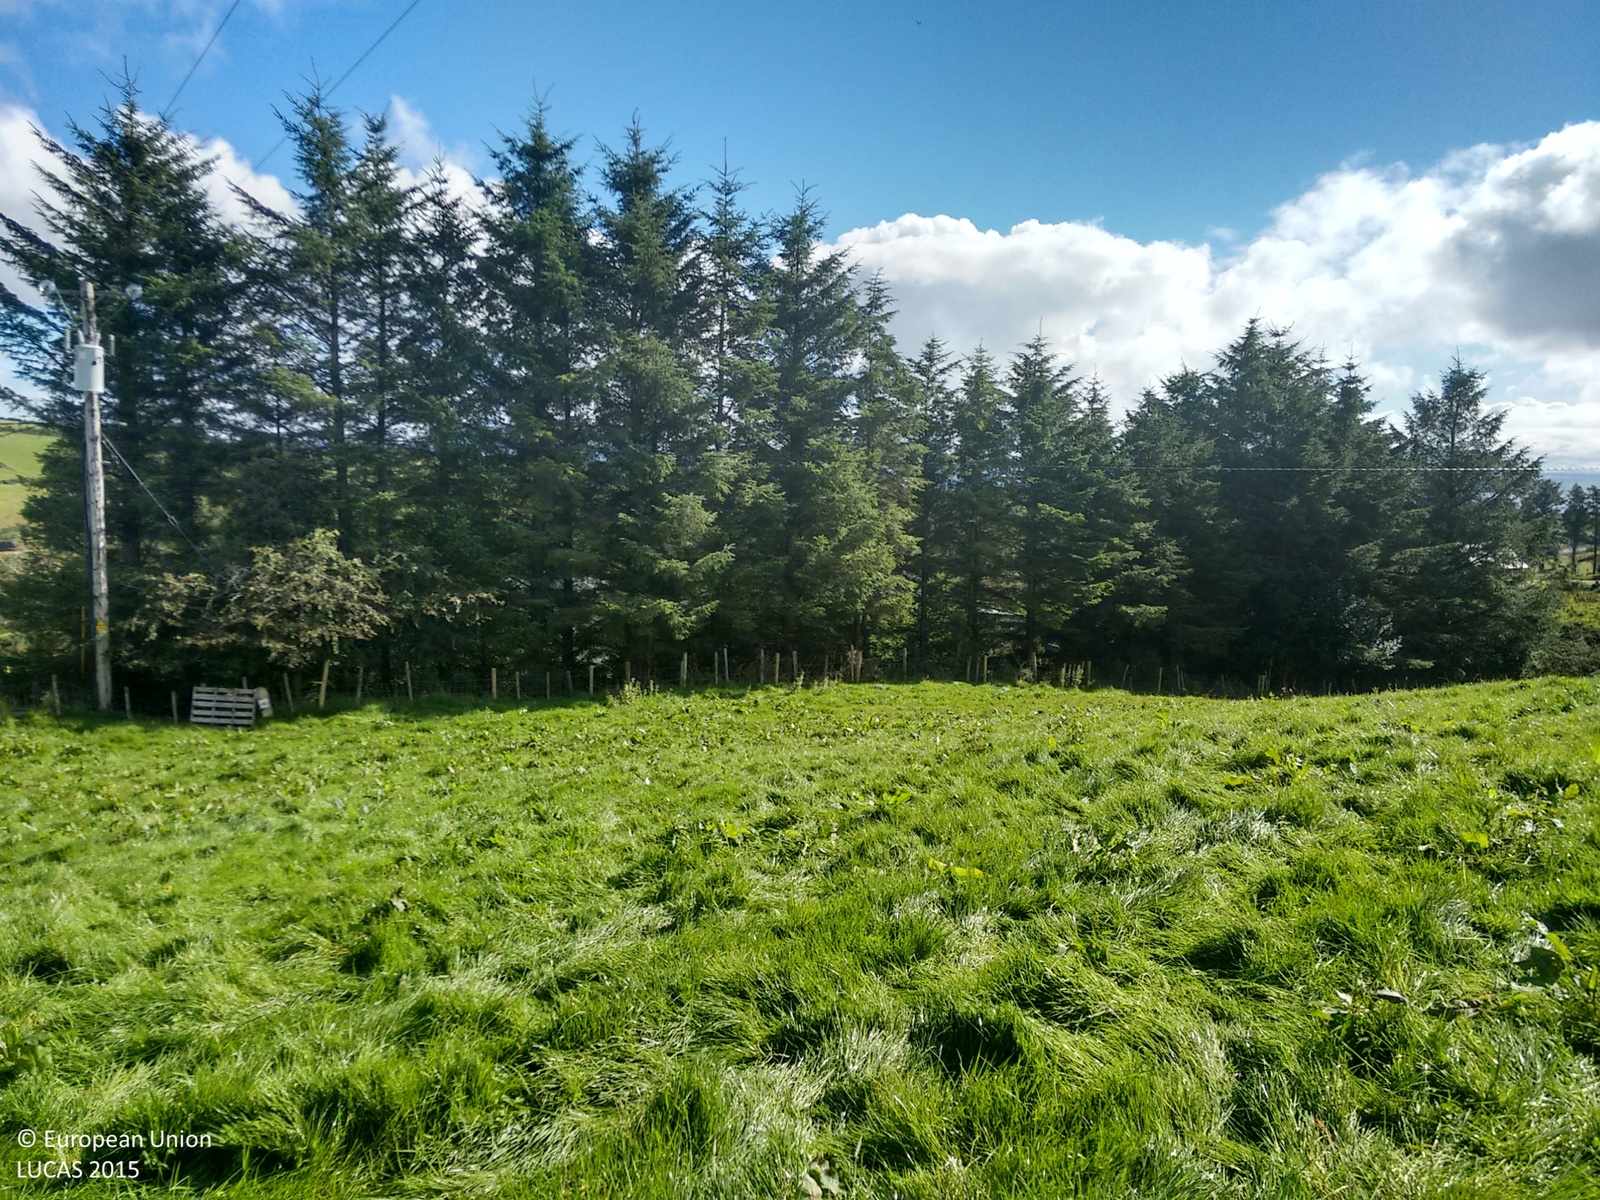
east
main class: Grassland
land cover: Grassland without tree/shrub cover
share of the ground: > 75 %
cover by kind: herbaceous plants 100 %
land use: Agriculture (excluding fallow land and kitchen gardens)
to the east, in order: Grassland without tree/shrub cover; Fences; Abandoned hedges; Fences; Grassland without tree/shrub cover; Electric lines; Grassland without tree/shrub cover; Fences; Spruce dominated coniferous woodland; Artificial constructions in urban areas; Managed hedges; Grassland without tree/shrub cover
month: September
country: IE
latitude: 55.1379
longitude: -7.2276
